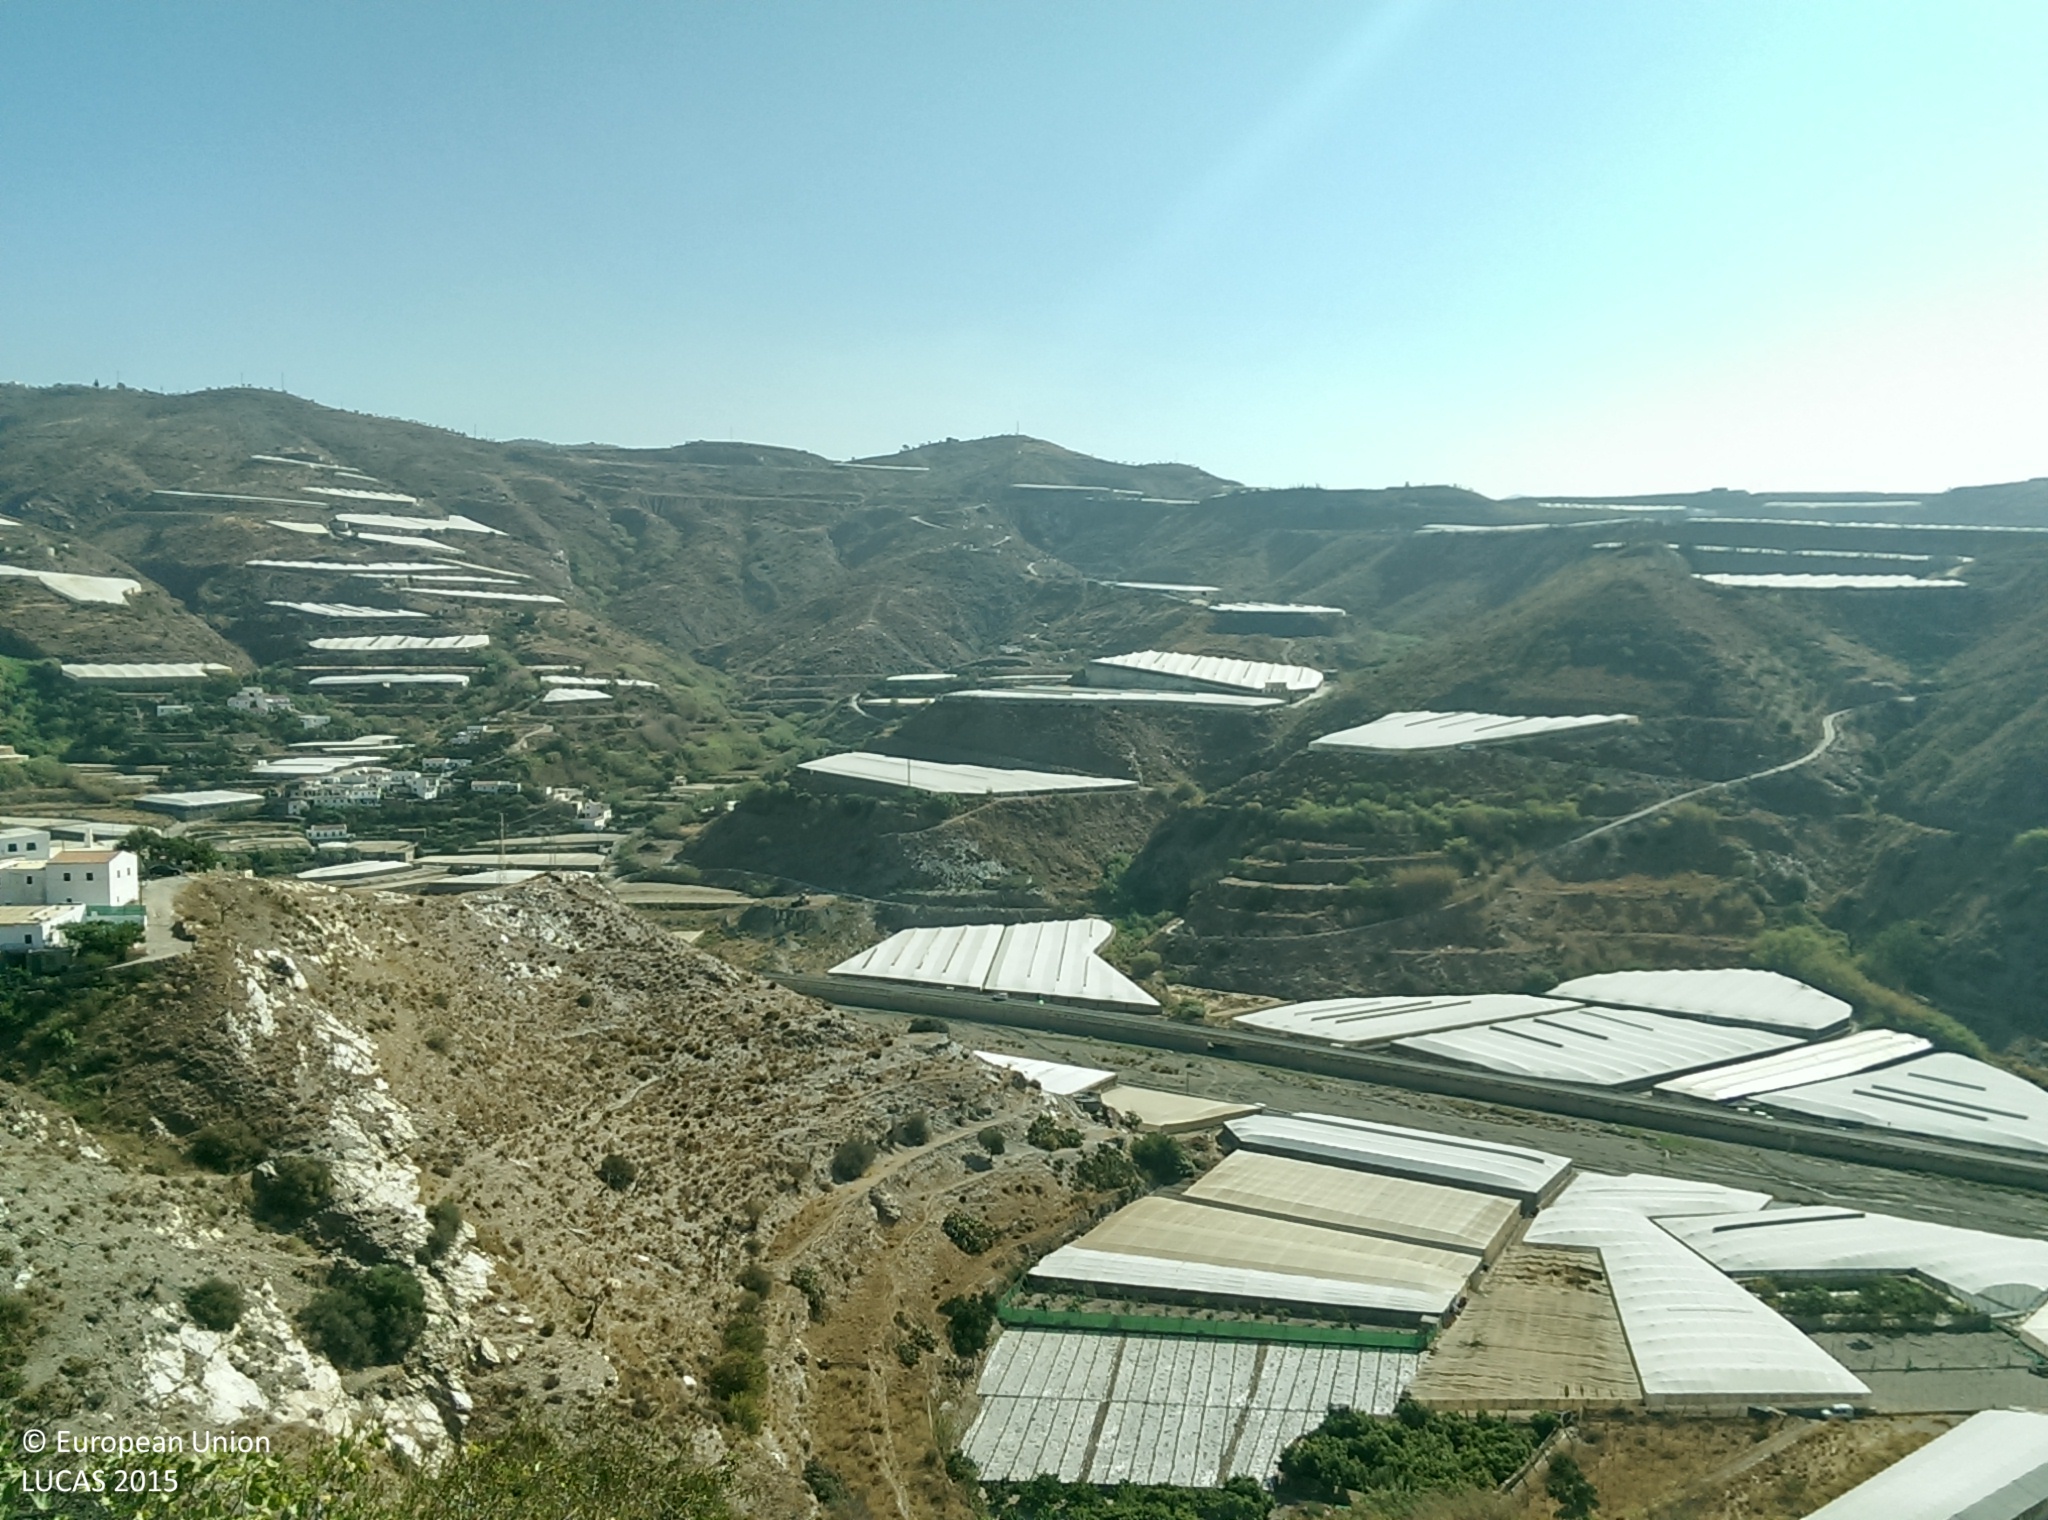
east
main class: Cropland
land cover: Nuts trees
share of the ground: 10 - 25 %
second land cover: Spontaneously vegetated surfaces
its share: > 75 %
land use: Abandoned areas
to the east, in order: Nuts trees; Spontaneously vegetated surfaces; Shrubland with sparse tree cover; Shrubland without tree cover; Dry stone walls; Artificial constructions in urban areas; Broadleaved woodland; Grassland with sparse tree/shrub cover; Artificial constructions in urban areas; Tracks; Artificial constructions in urban areas; Electric lines; Tracks
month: August
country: ES
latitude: 36.7697
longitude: -3.1878
